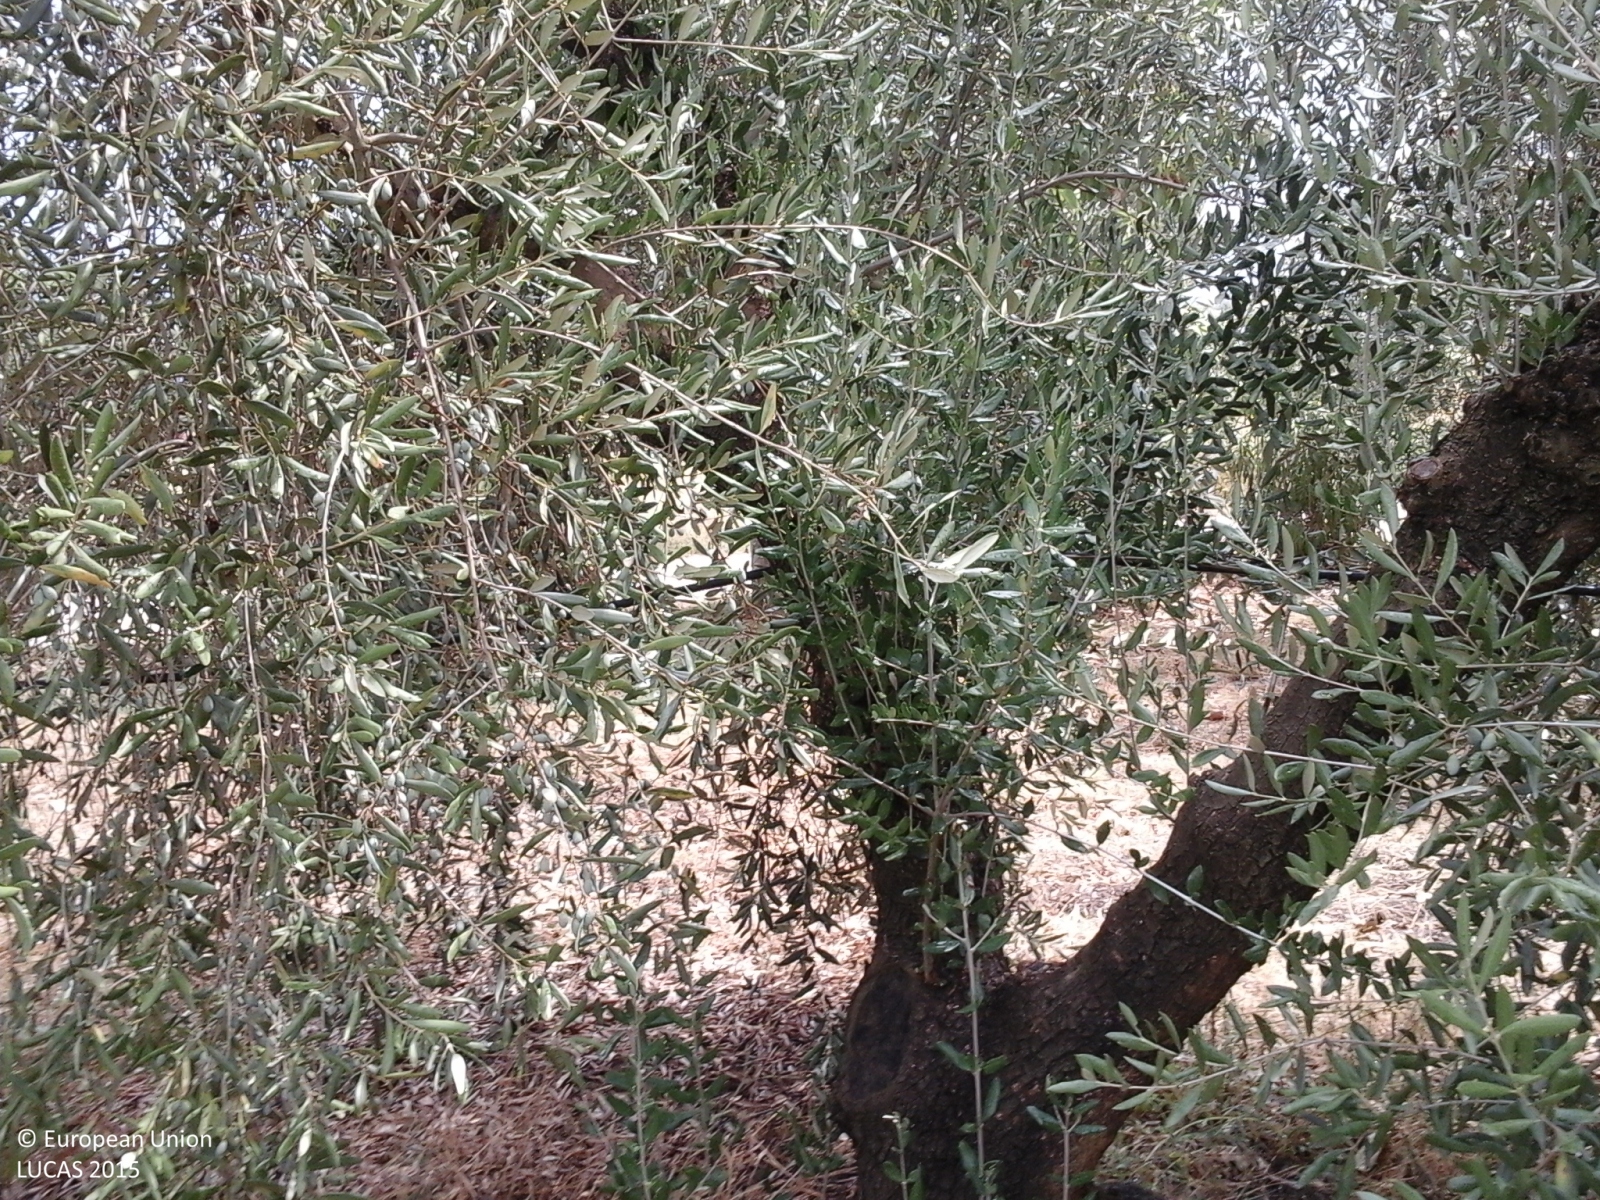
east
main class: Cropland
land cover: Olive groves
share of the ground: 50 - 75 %
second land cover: Grassland without tree/shrub cover
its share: 10 - 25 %
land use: Agriculture (excluding fallow land and kitchen gardens)
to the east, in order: Olive groves; Grassland without tree/shrub cover; Managed hedges; Ditches and canals; Paved roads, cycling and walking lanes; Ditches and canals; Grassland without tree/shrub cover; Olive groves; Grass margins; Paved roads, cycling and walking lanes; Grass margins; Ditches and canals; Other bare soil
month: August
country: IT
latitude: 42.8840
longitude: 10.9886
